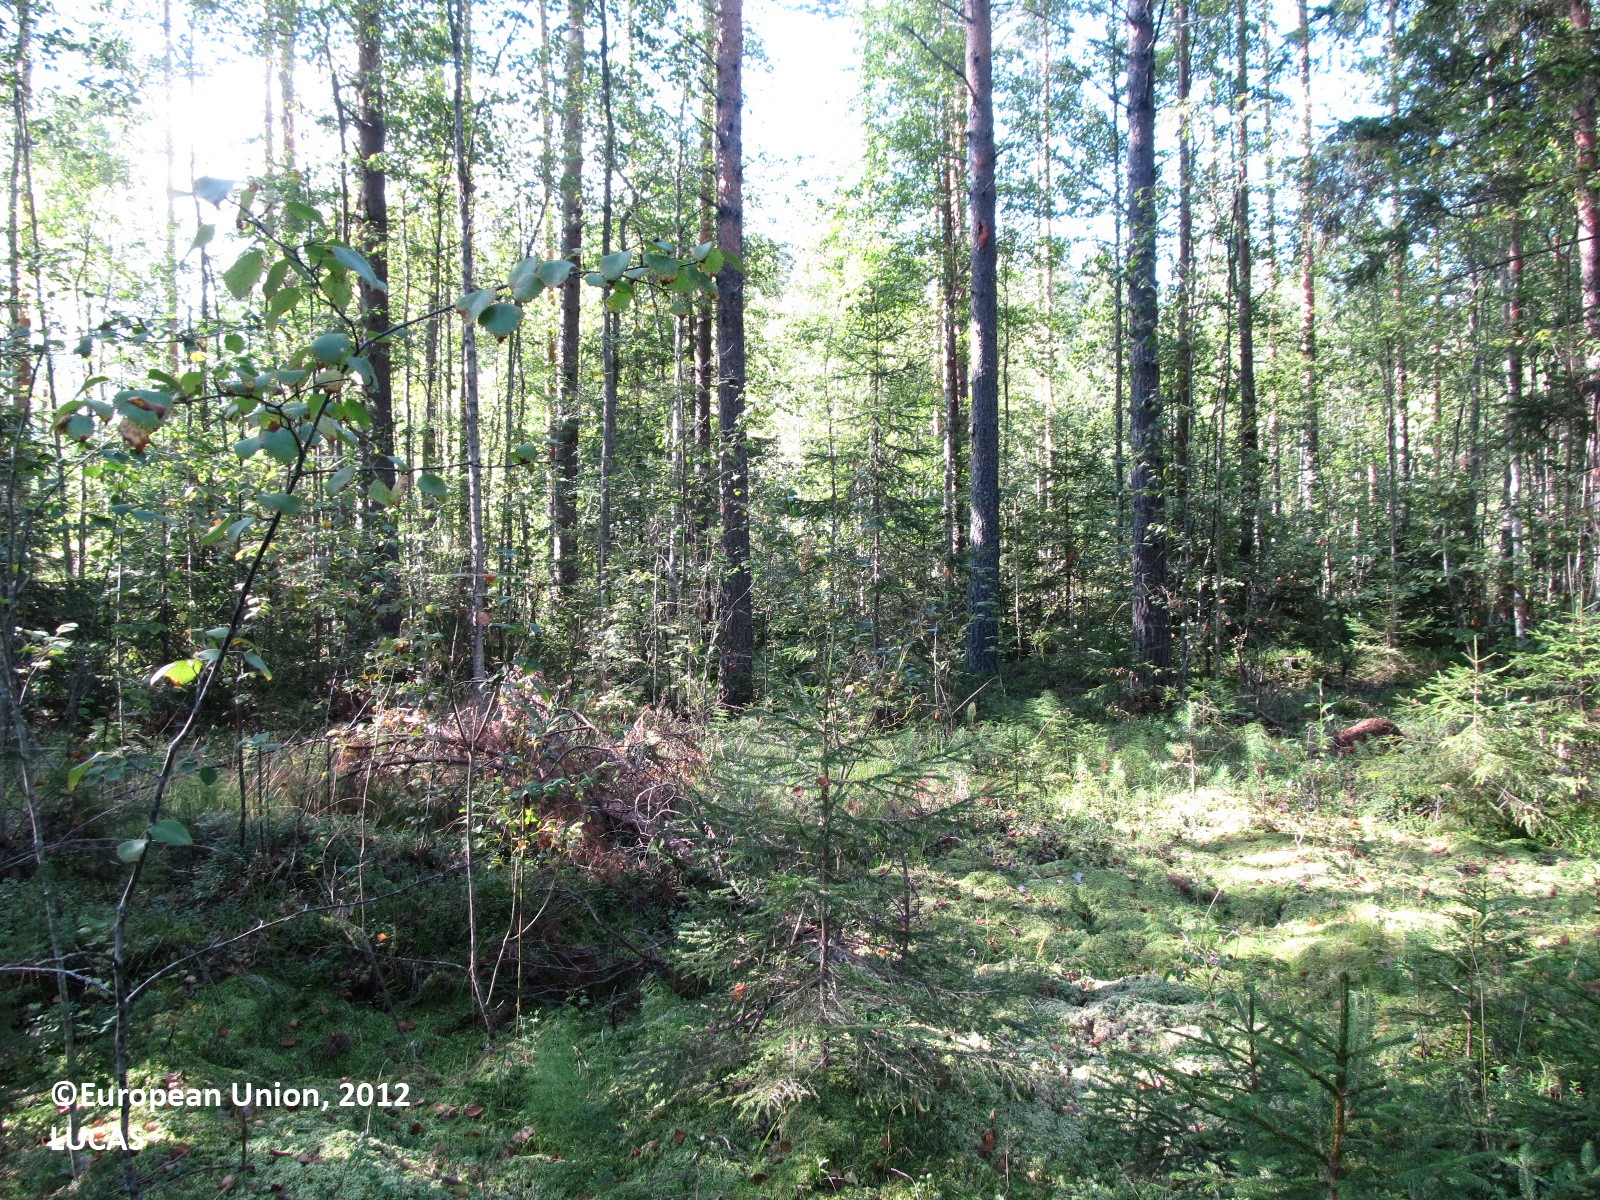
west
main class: Woodland
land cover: Pine dominated mixed woodland
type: boreal forest
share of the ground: 50 - 75 %
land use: Forestry
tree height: > 5 m
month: August
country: FI
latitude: 62.1672
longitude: 27.5078
